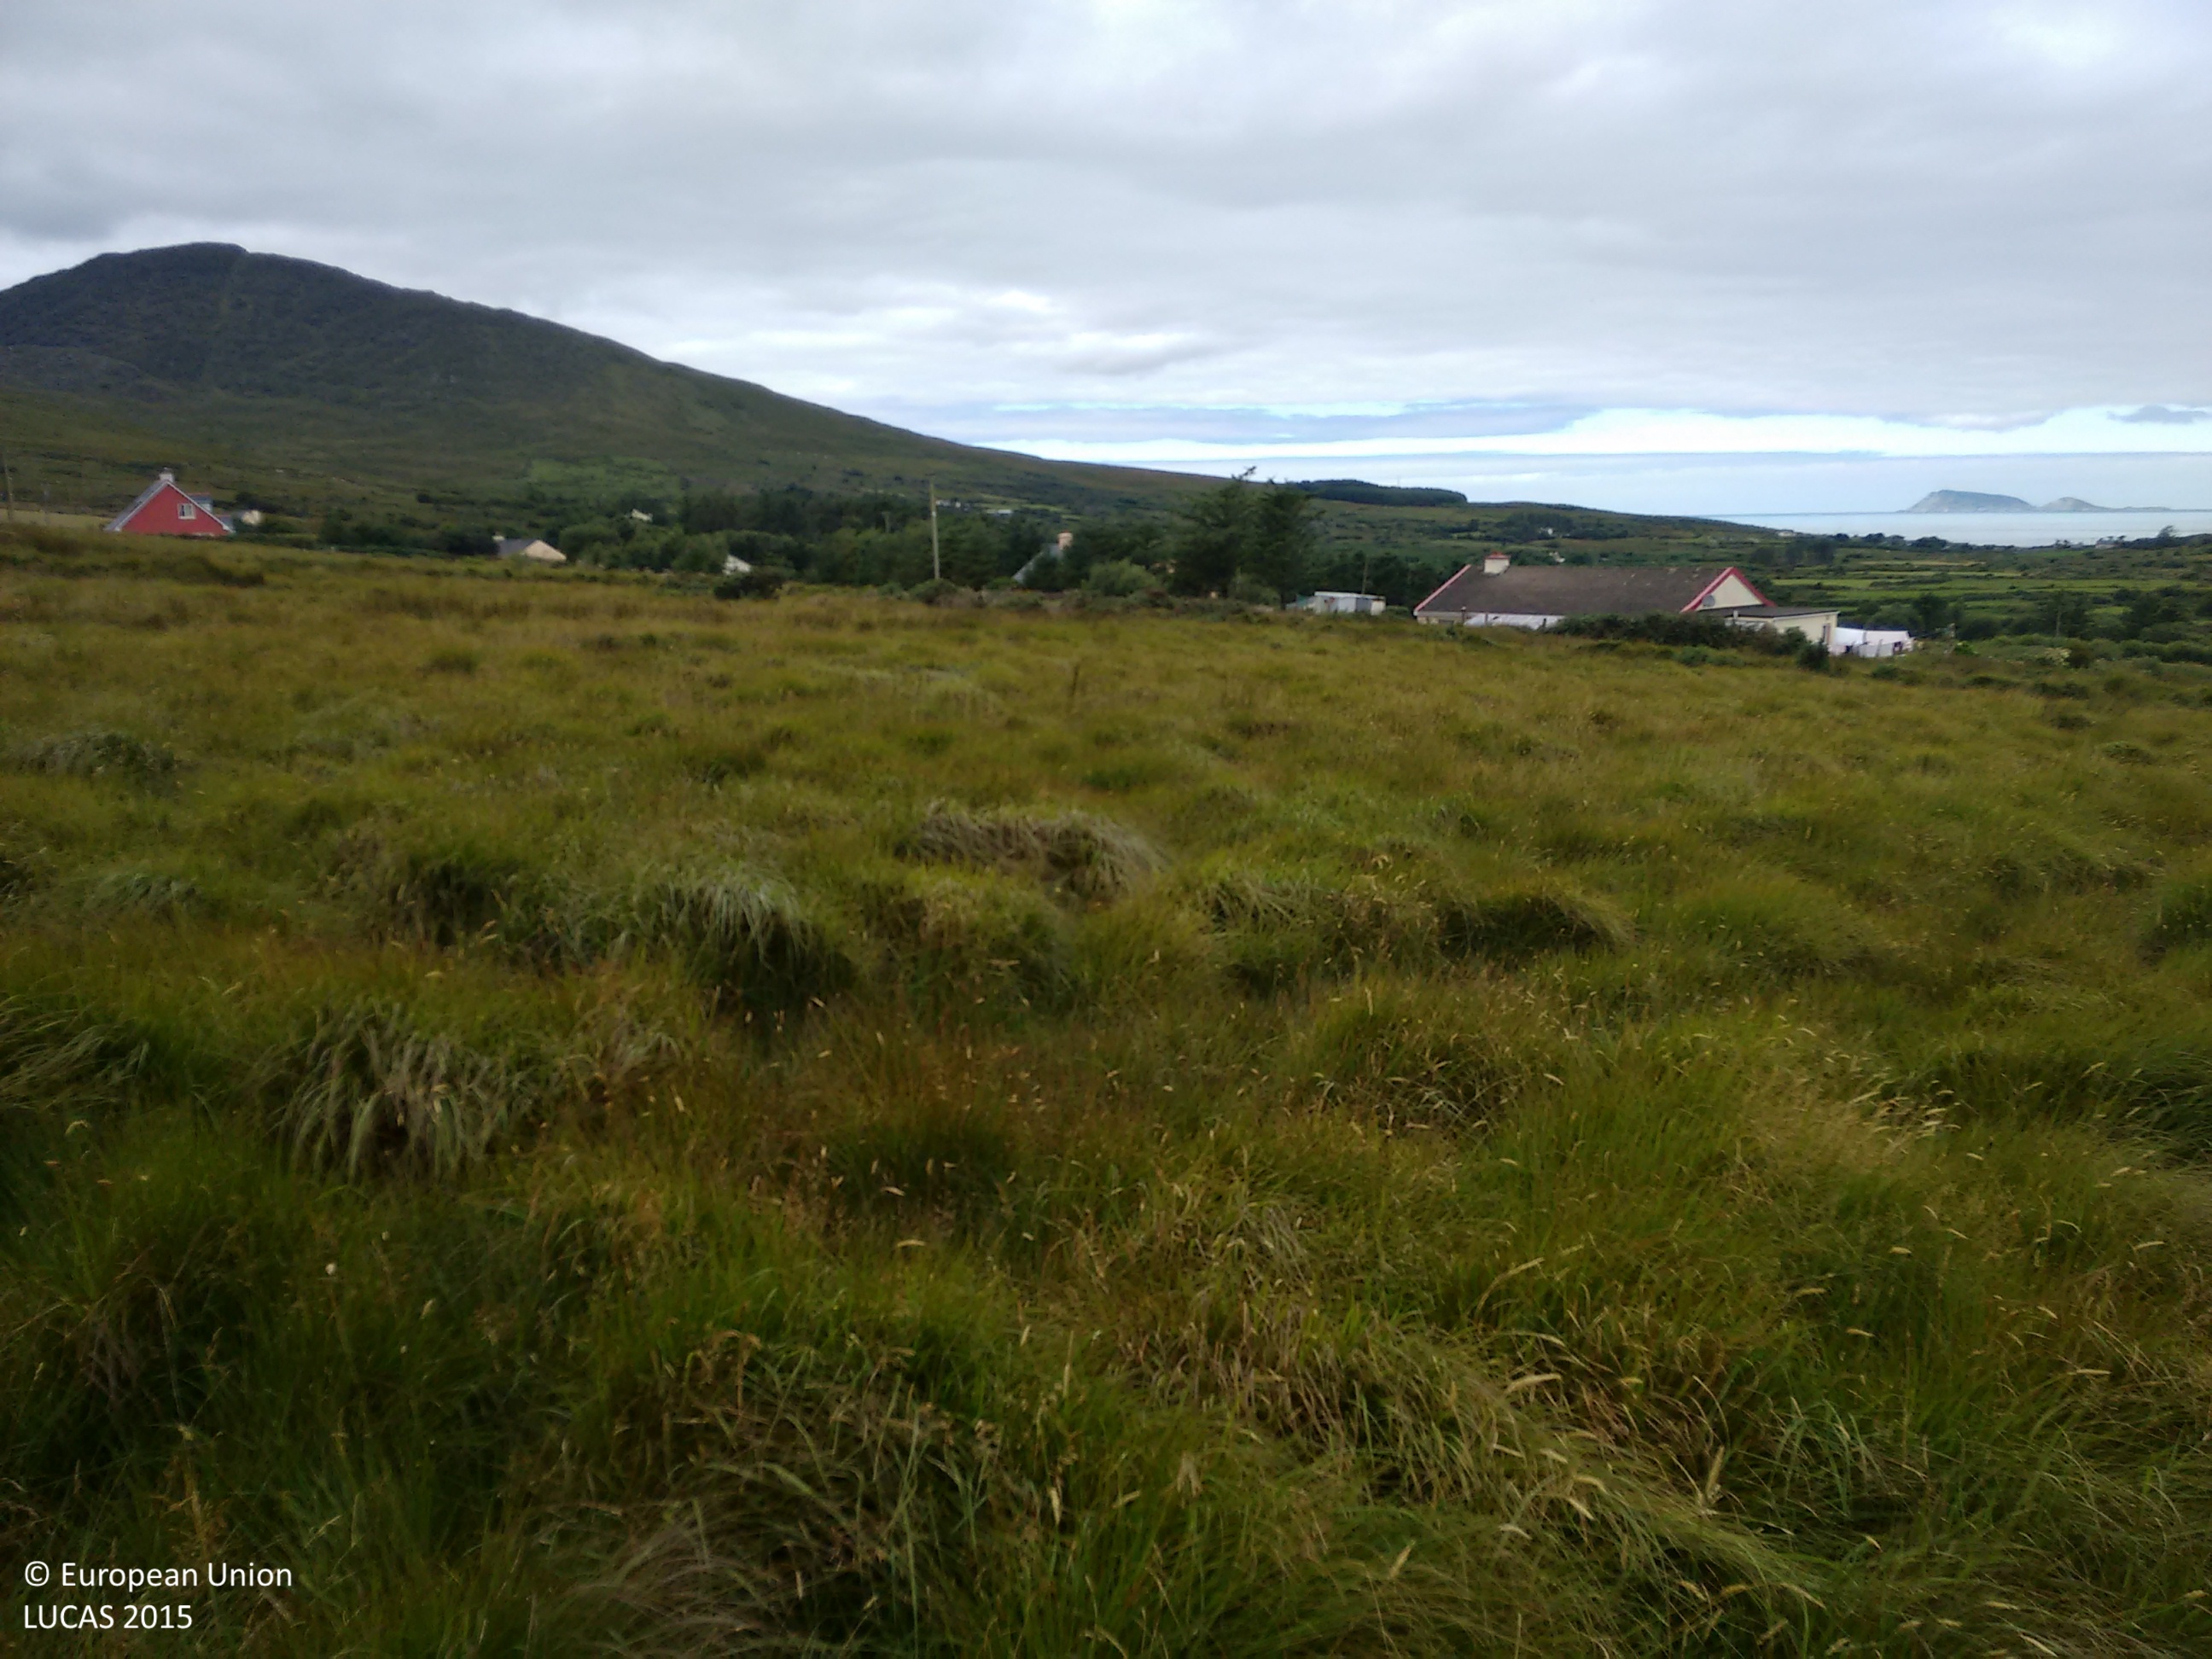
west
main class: Grassland
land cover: Grassland without tree/shrub cover
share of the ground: > 75 %
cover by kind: herbaceous plants 100 %
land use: Agriculture (excluding fallow land and kitchen gardens)
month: August
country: IE
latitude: 51.6808
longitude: -9.9351
